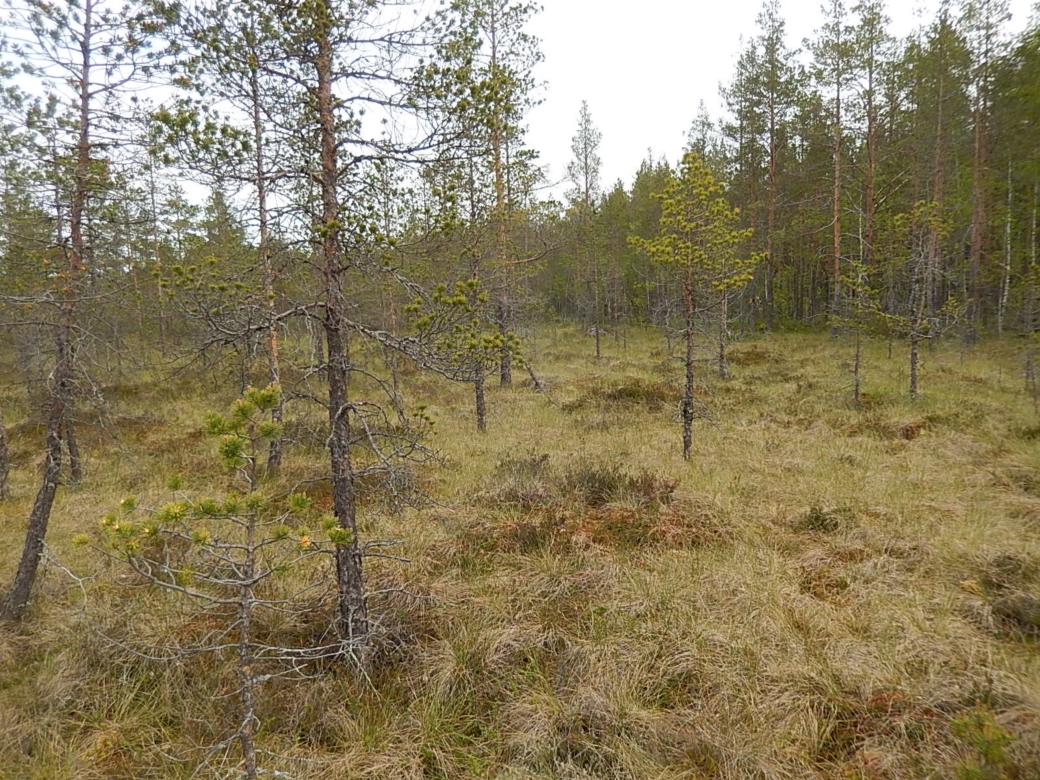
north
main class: Woodland
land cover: Pine dominated coniferous woodland
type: boreal forest
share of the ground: 50 - 75 %
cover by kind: coniferous forest trees 50 %, herbaceous plants 20 %, lichens and mosses 20 %, shrubs 10 %
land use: Forestry
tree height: > 5 m
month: June
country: FI
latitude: 61.9321
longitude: 22.1917
